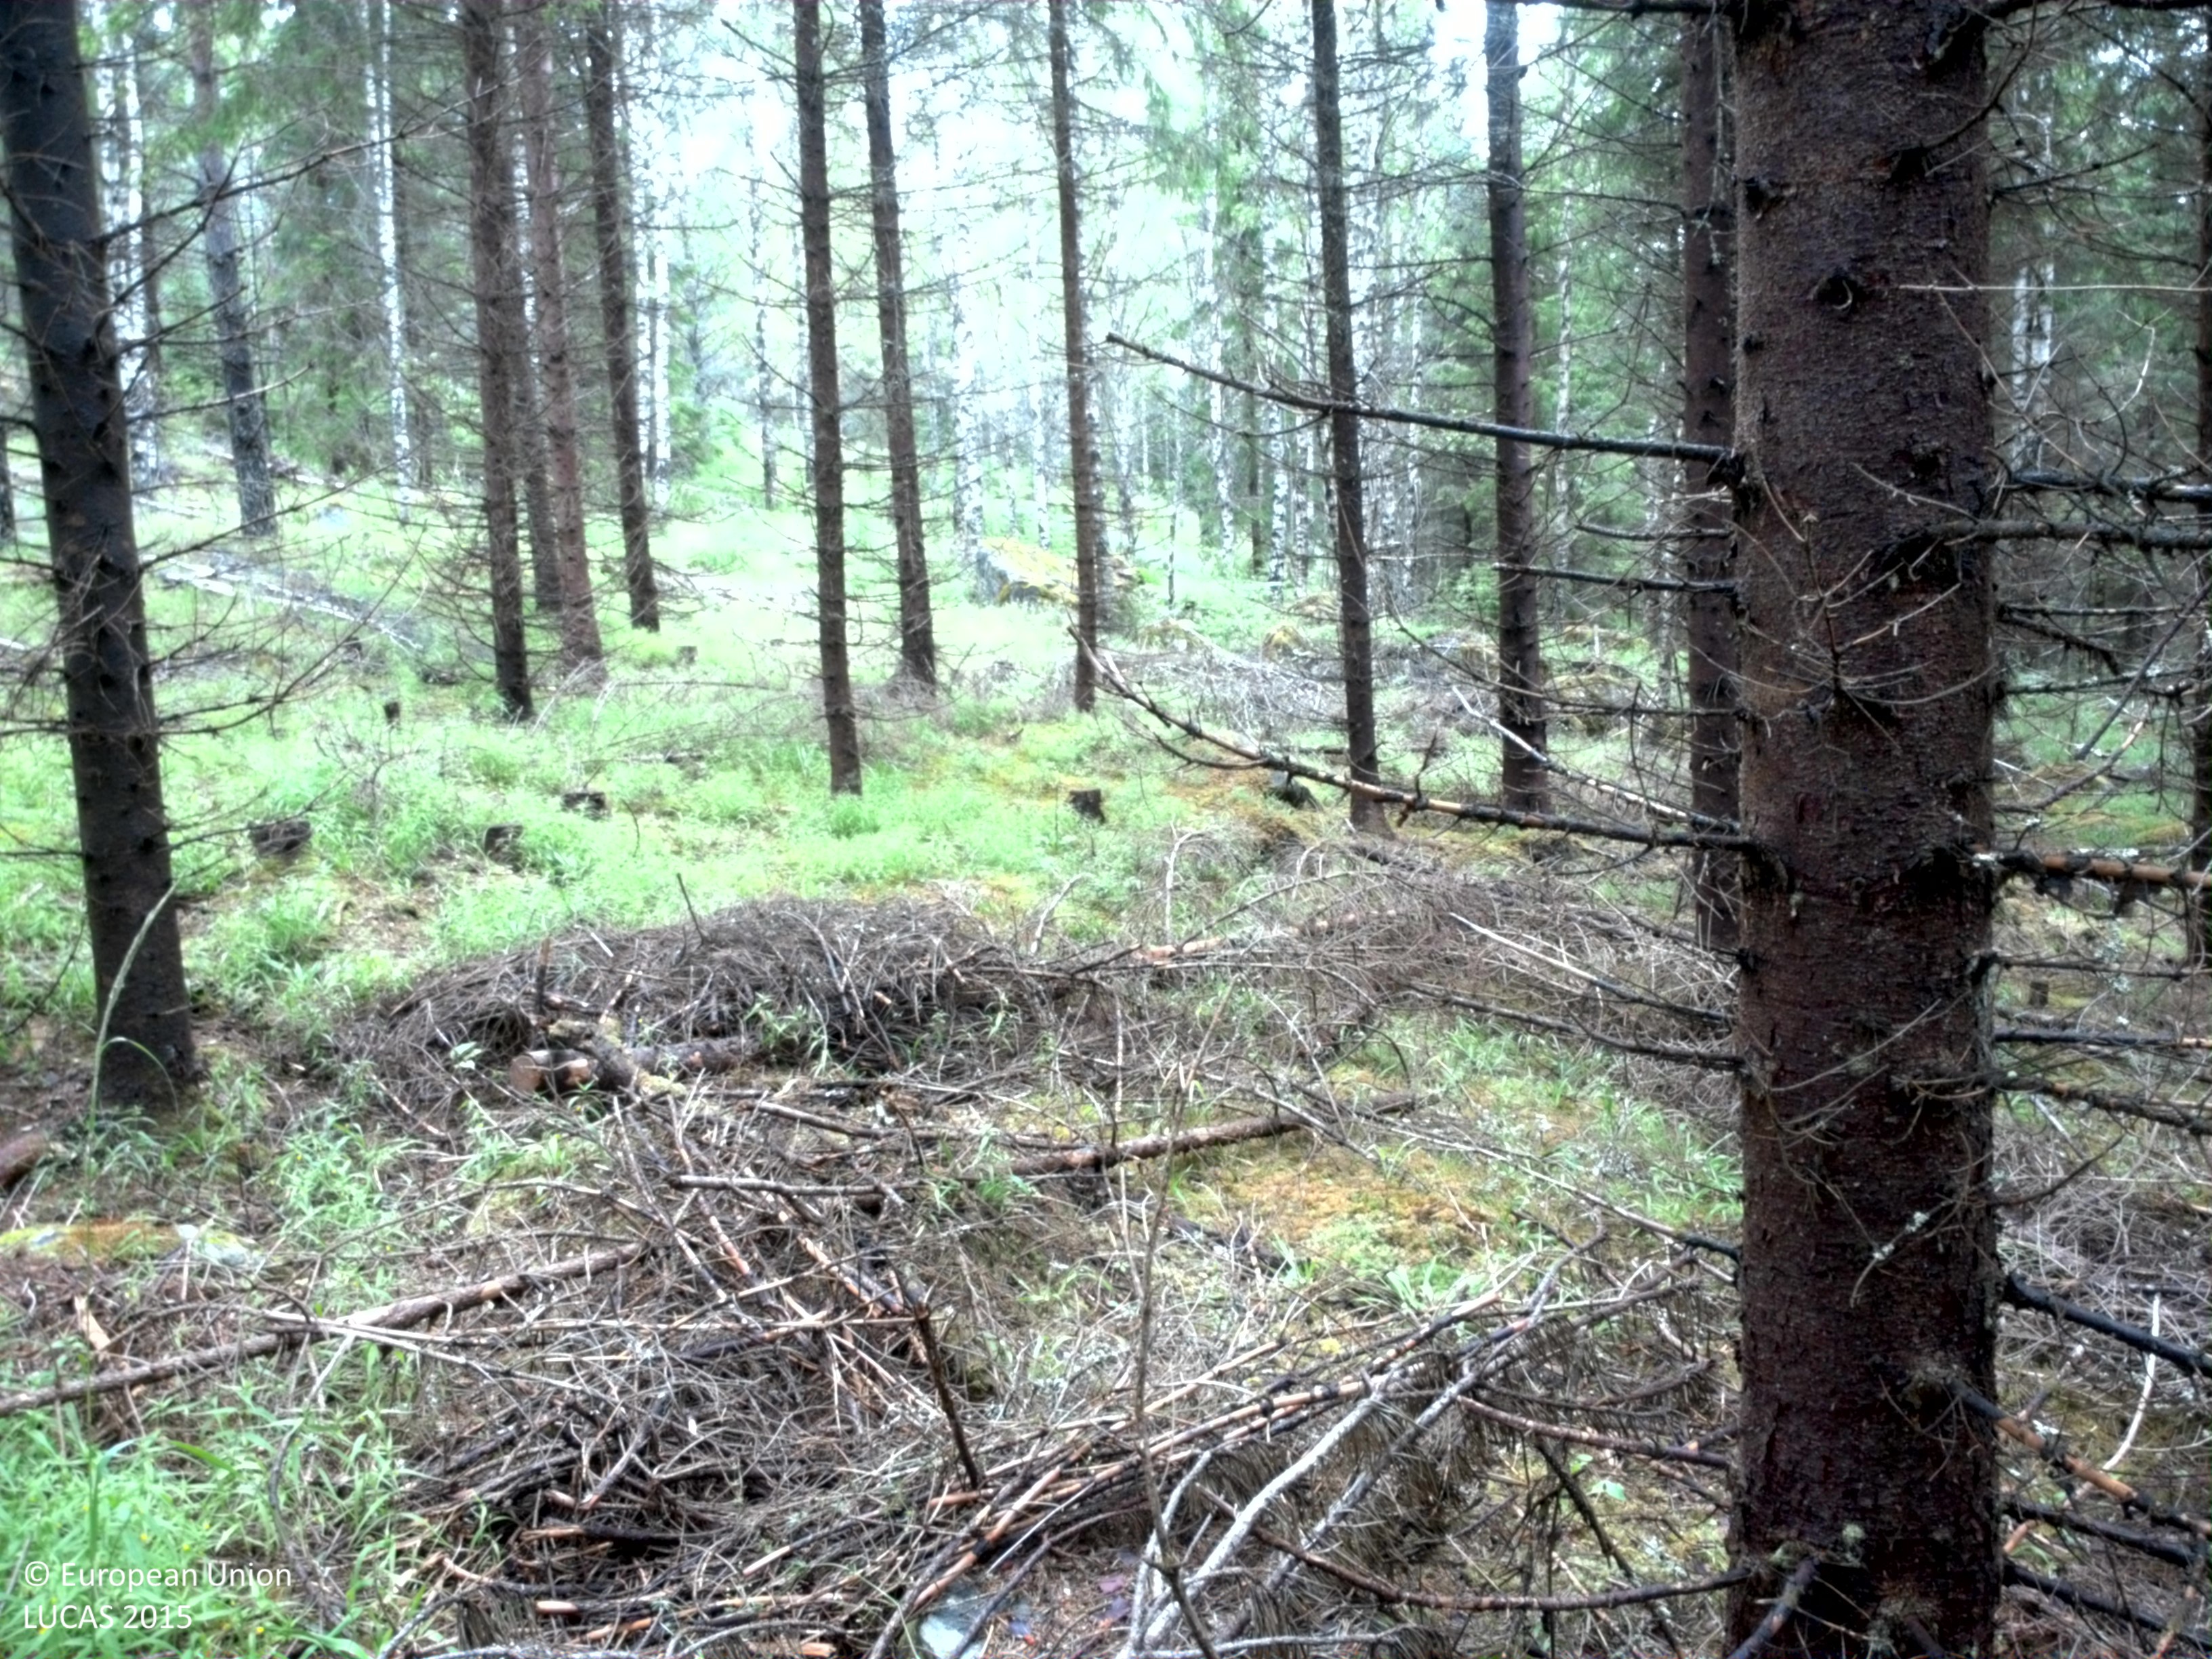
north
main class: Woodland
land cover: Spruce dominated coniferous woodland
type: boreal forest
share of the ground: 50 - 75 %
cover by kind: coniferous forest trees 65 %, lichens and mosses 30 %, herbaceous plants 5 %
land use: Forestry
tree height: > 5 m
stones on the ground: 25 - 50 %
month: July
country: SE
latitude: 59.2420
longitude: 12.3959
